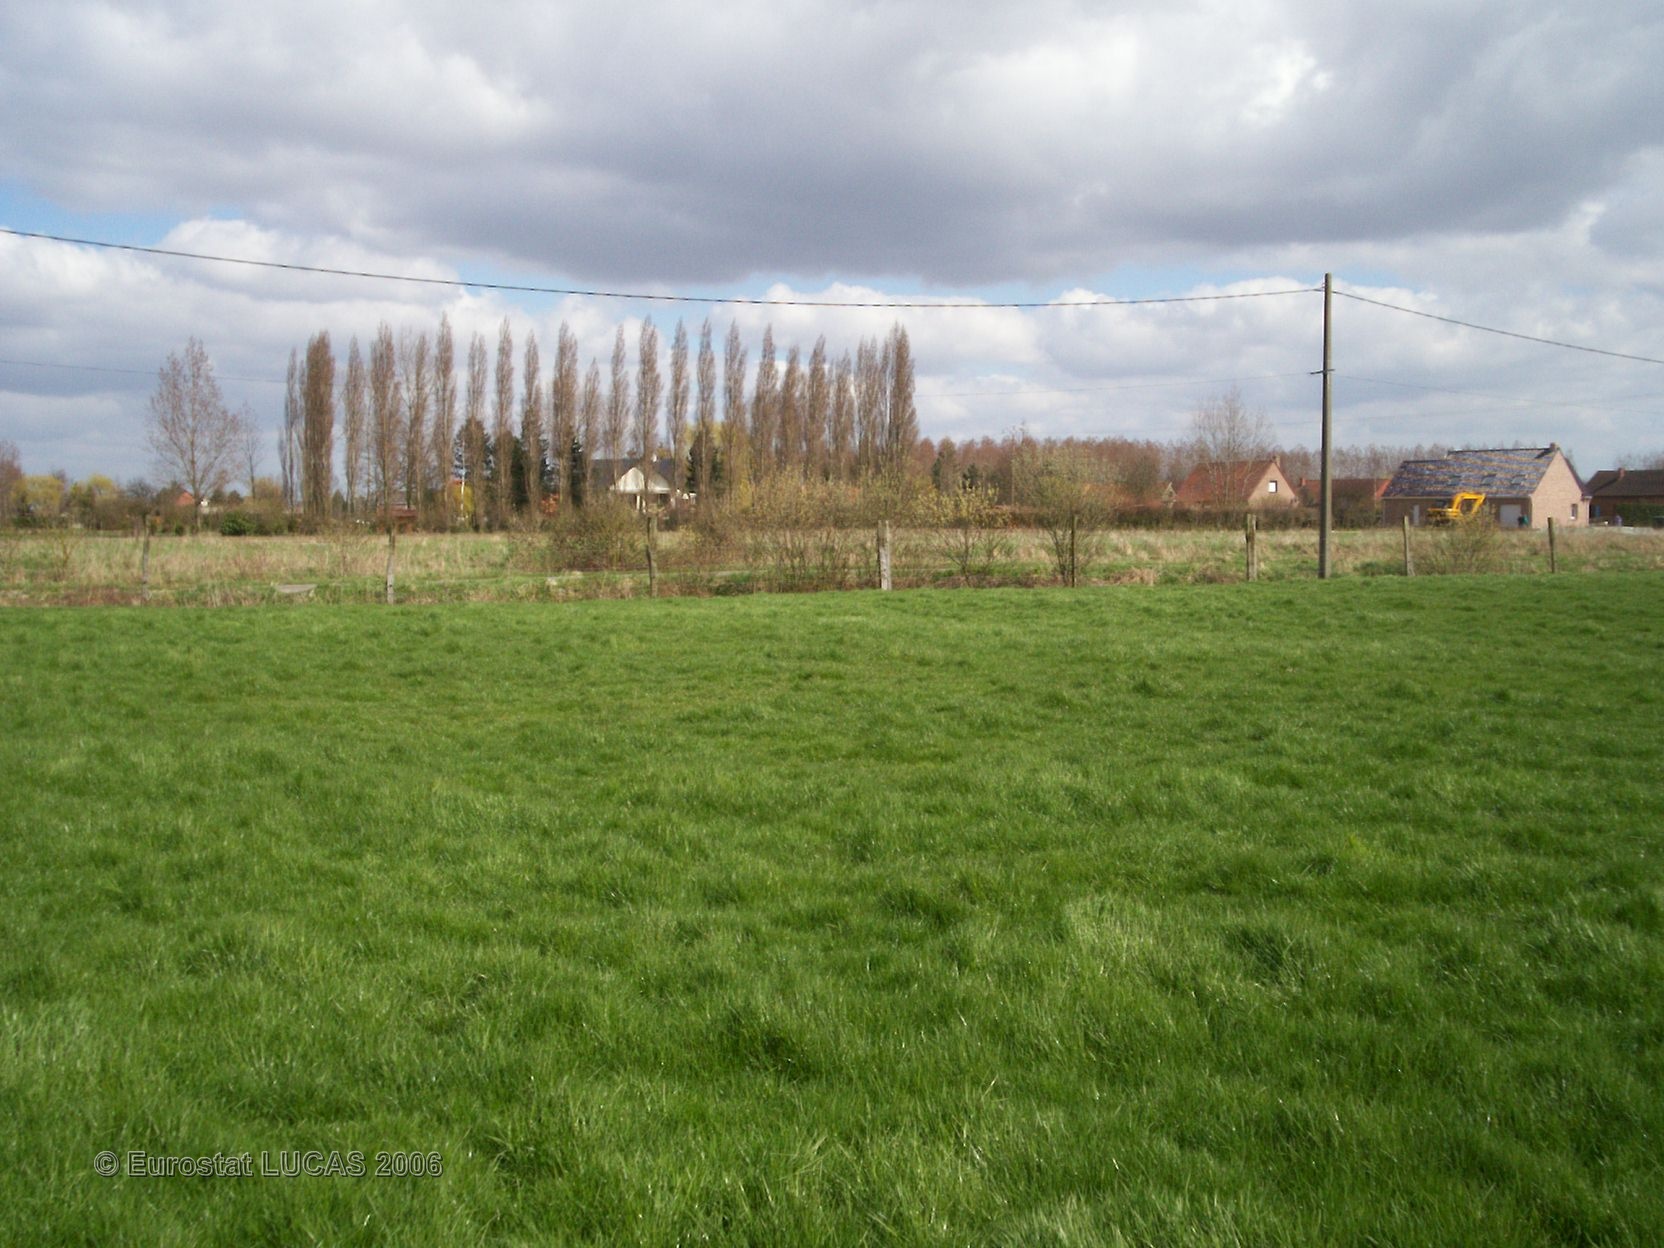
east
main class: Grassland
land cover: Grassland without tree/shrub cover
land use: Agriculture (excluding fallow land and kitchen gardens)
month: April
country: FR
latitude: 50.5937
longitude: 2.5998
